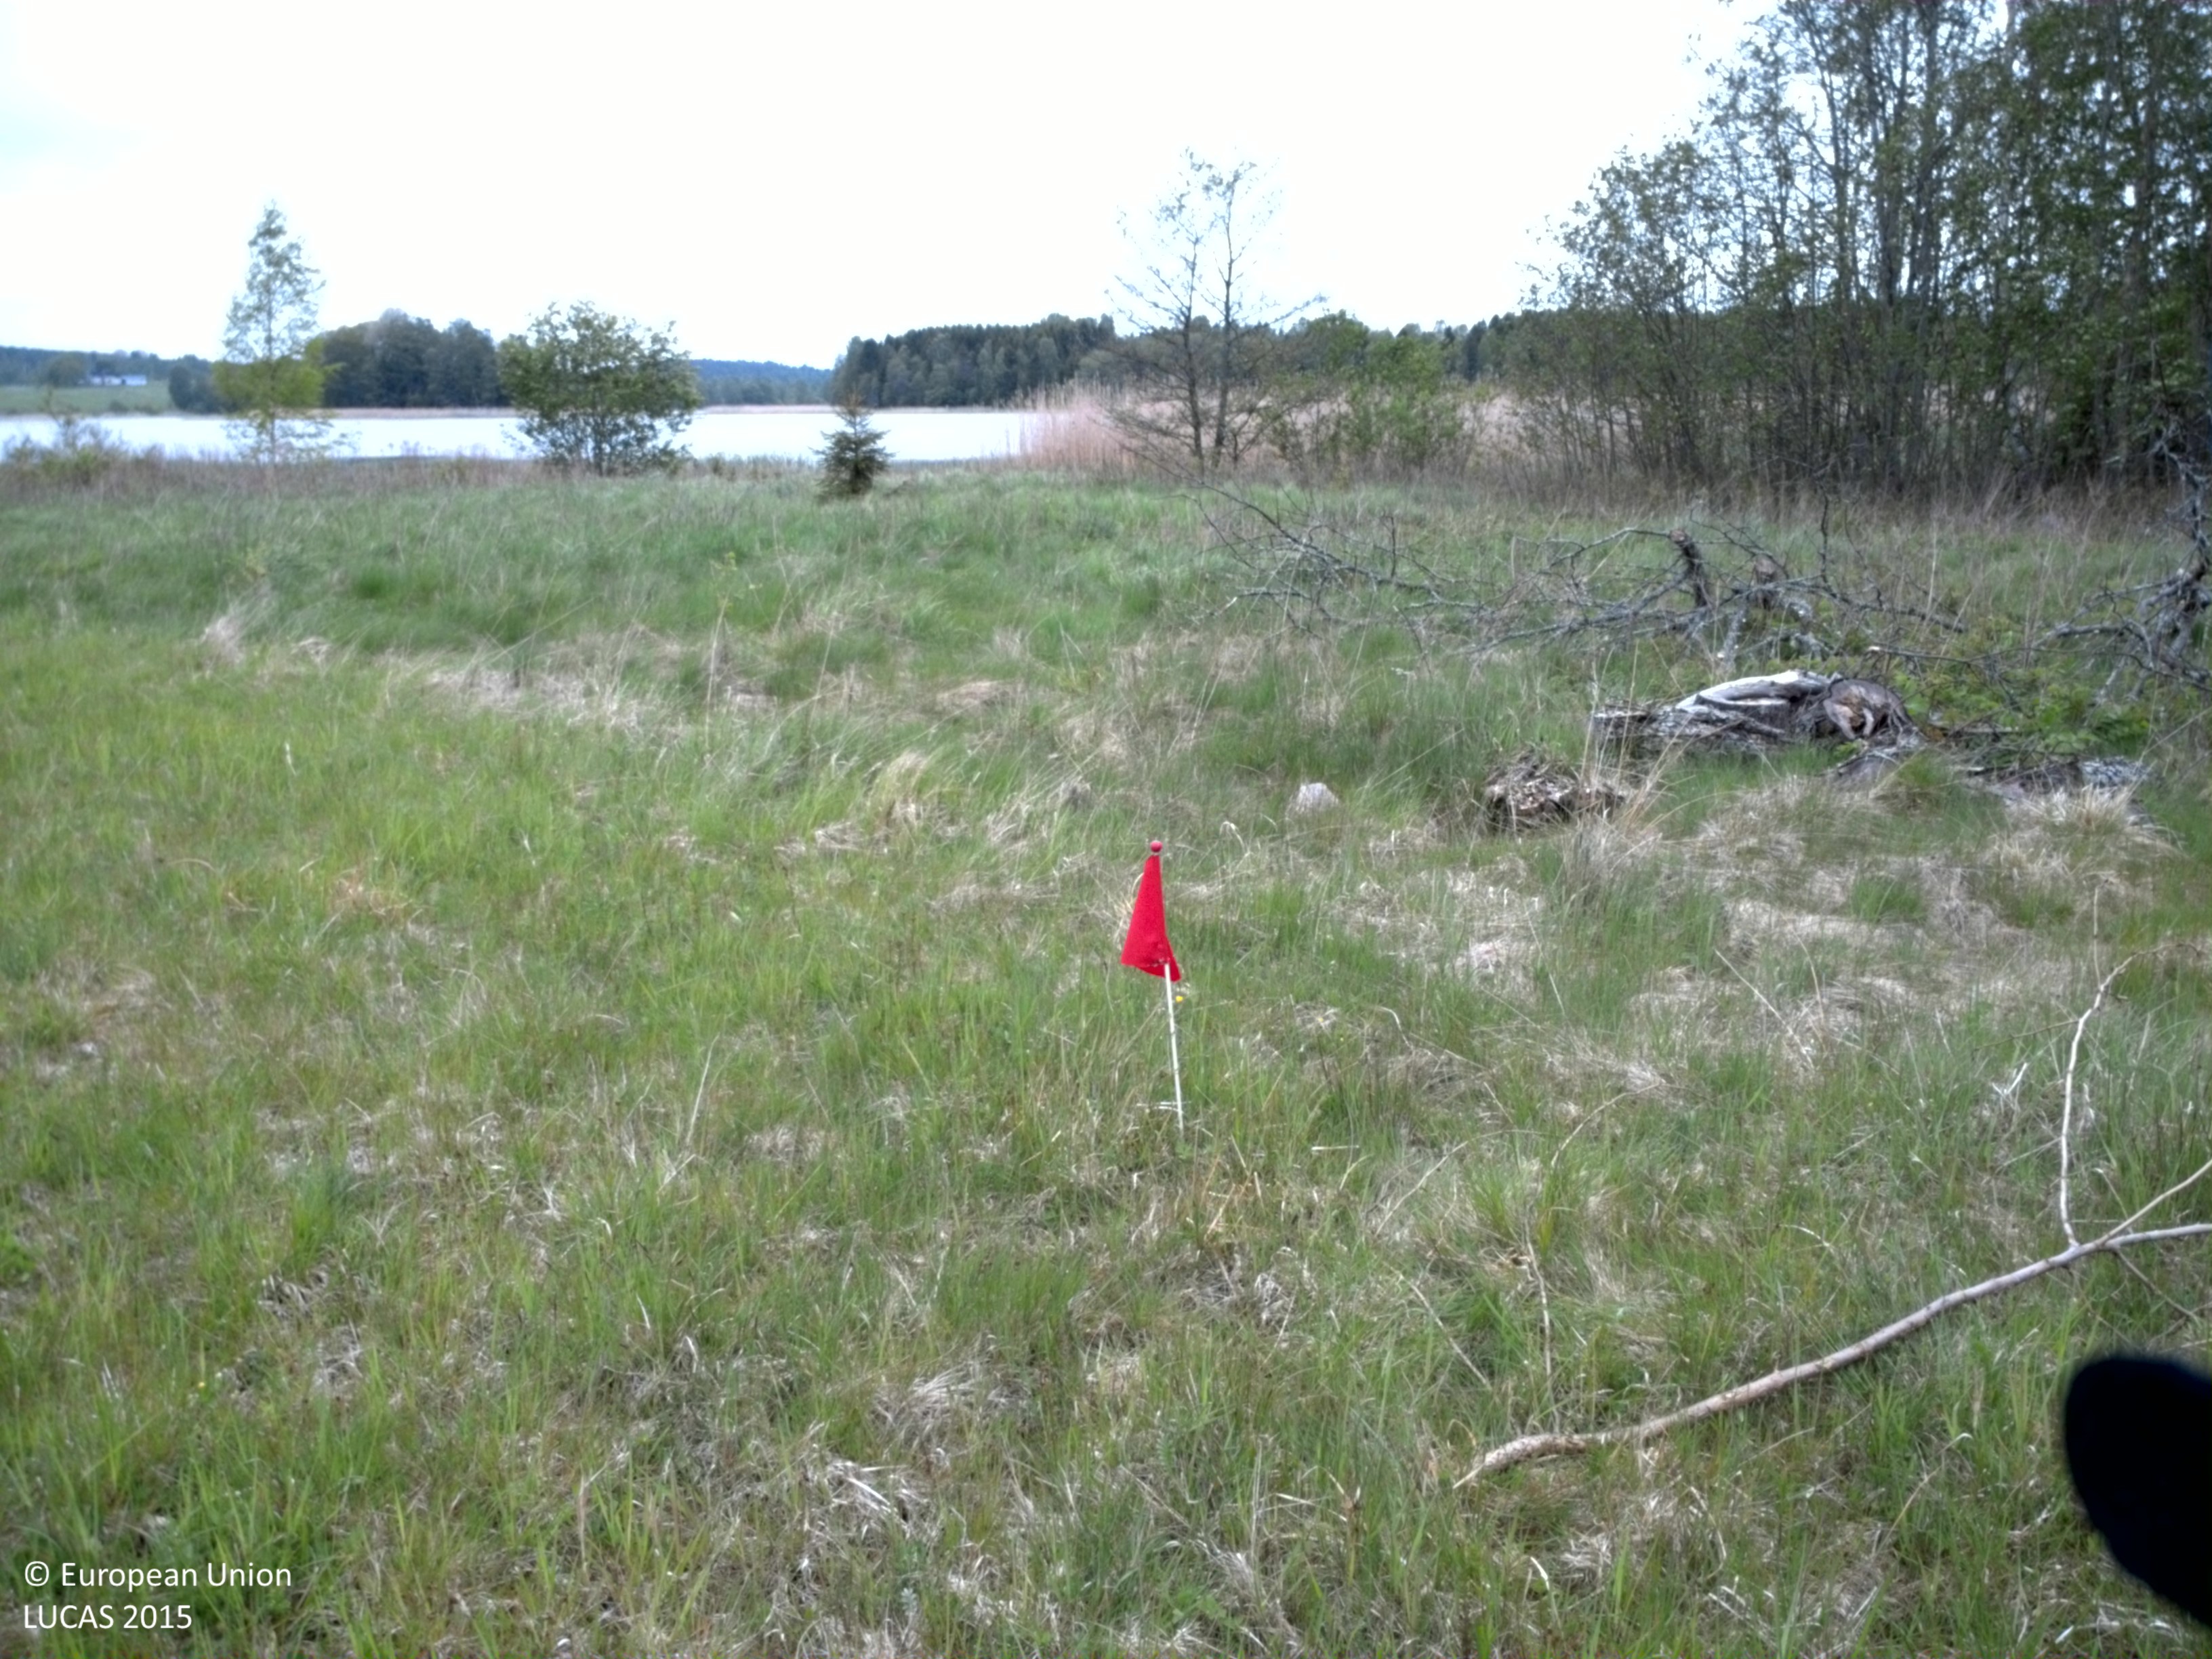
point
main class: Grassland
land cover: Grassland without tree/shrub cover
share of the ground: > 75 %
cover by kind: herbaceous plants 100 %
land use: Agriculture (excluding fallow land and kitchen gardens)
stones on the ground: < 10 %
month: June
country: SE
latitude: 59.7461
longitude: 12.3957
